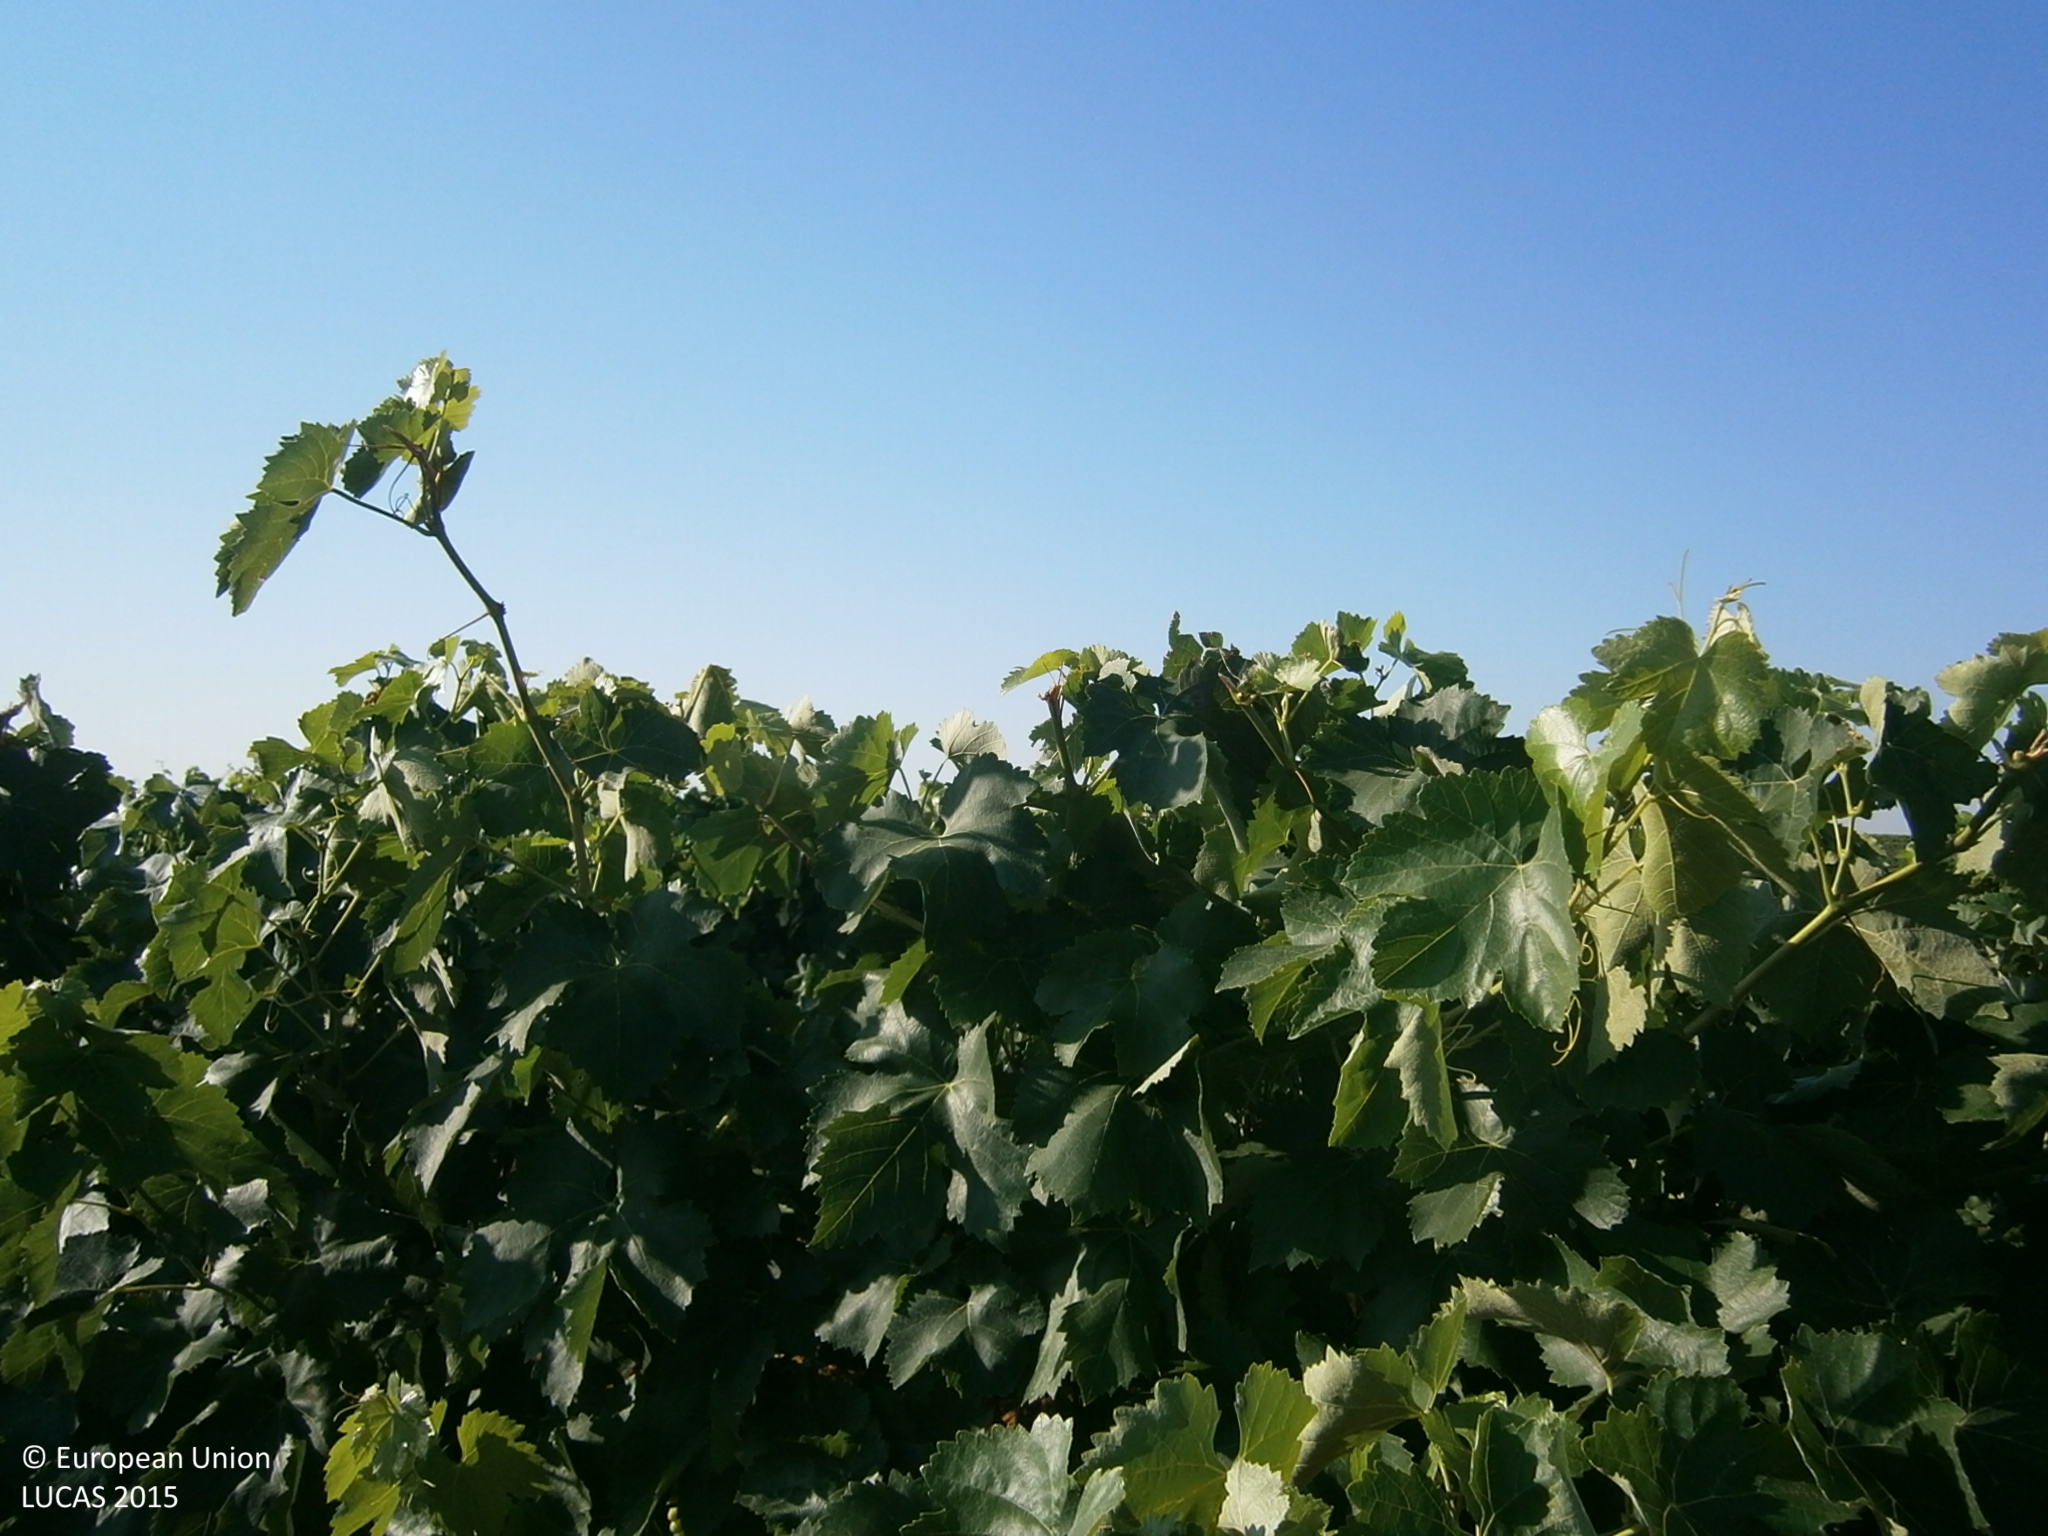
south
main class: Cropland
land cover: Vineyards
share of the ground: 25 - 50 %
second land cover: Other bare soil
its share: > 75 %
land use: Agriculture (excluding fallow land and kitchen gardens)
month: June
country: ES
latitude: 38.7938
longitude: -6.7699
